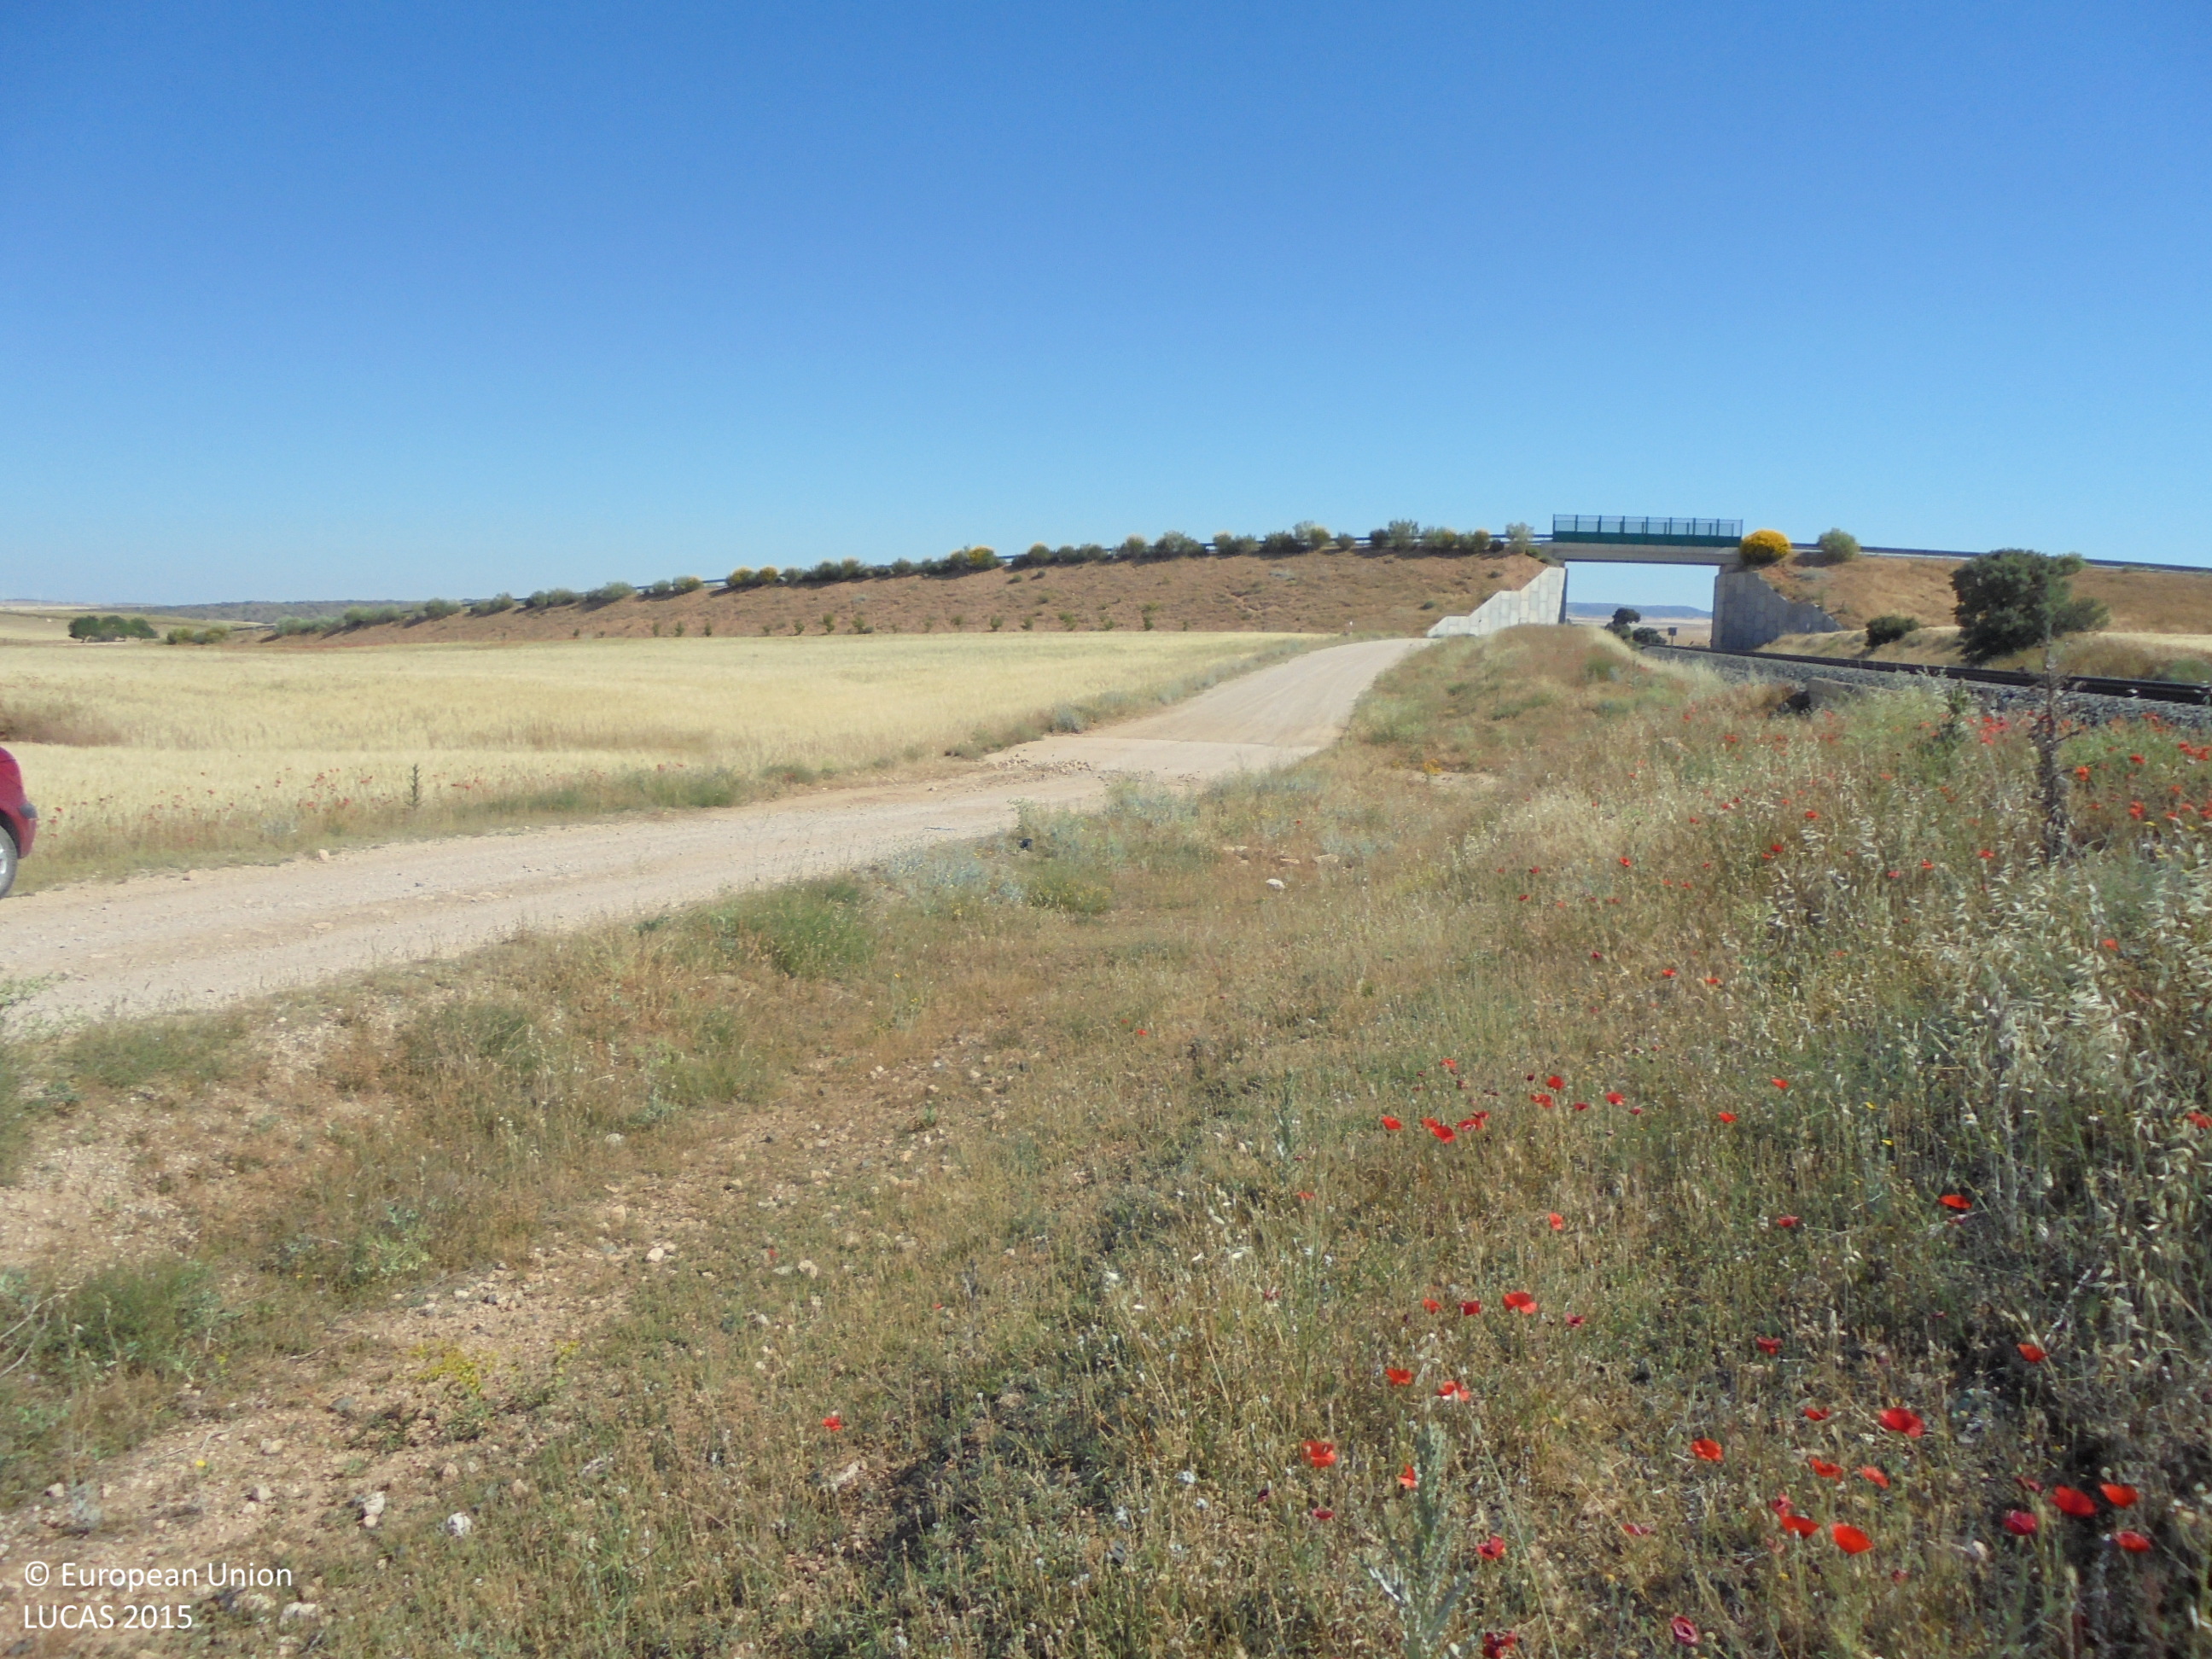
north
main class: Grassland
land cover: Grassland without tree/shrub cover
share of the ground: > 75 %
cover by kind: herbaceous plants 85 %, unconsolidated bare surface 15 %
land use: Semi-natural and natural areas not in use
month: June
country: ES
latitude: 38.8323
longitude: -1.7128
